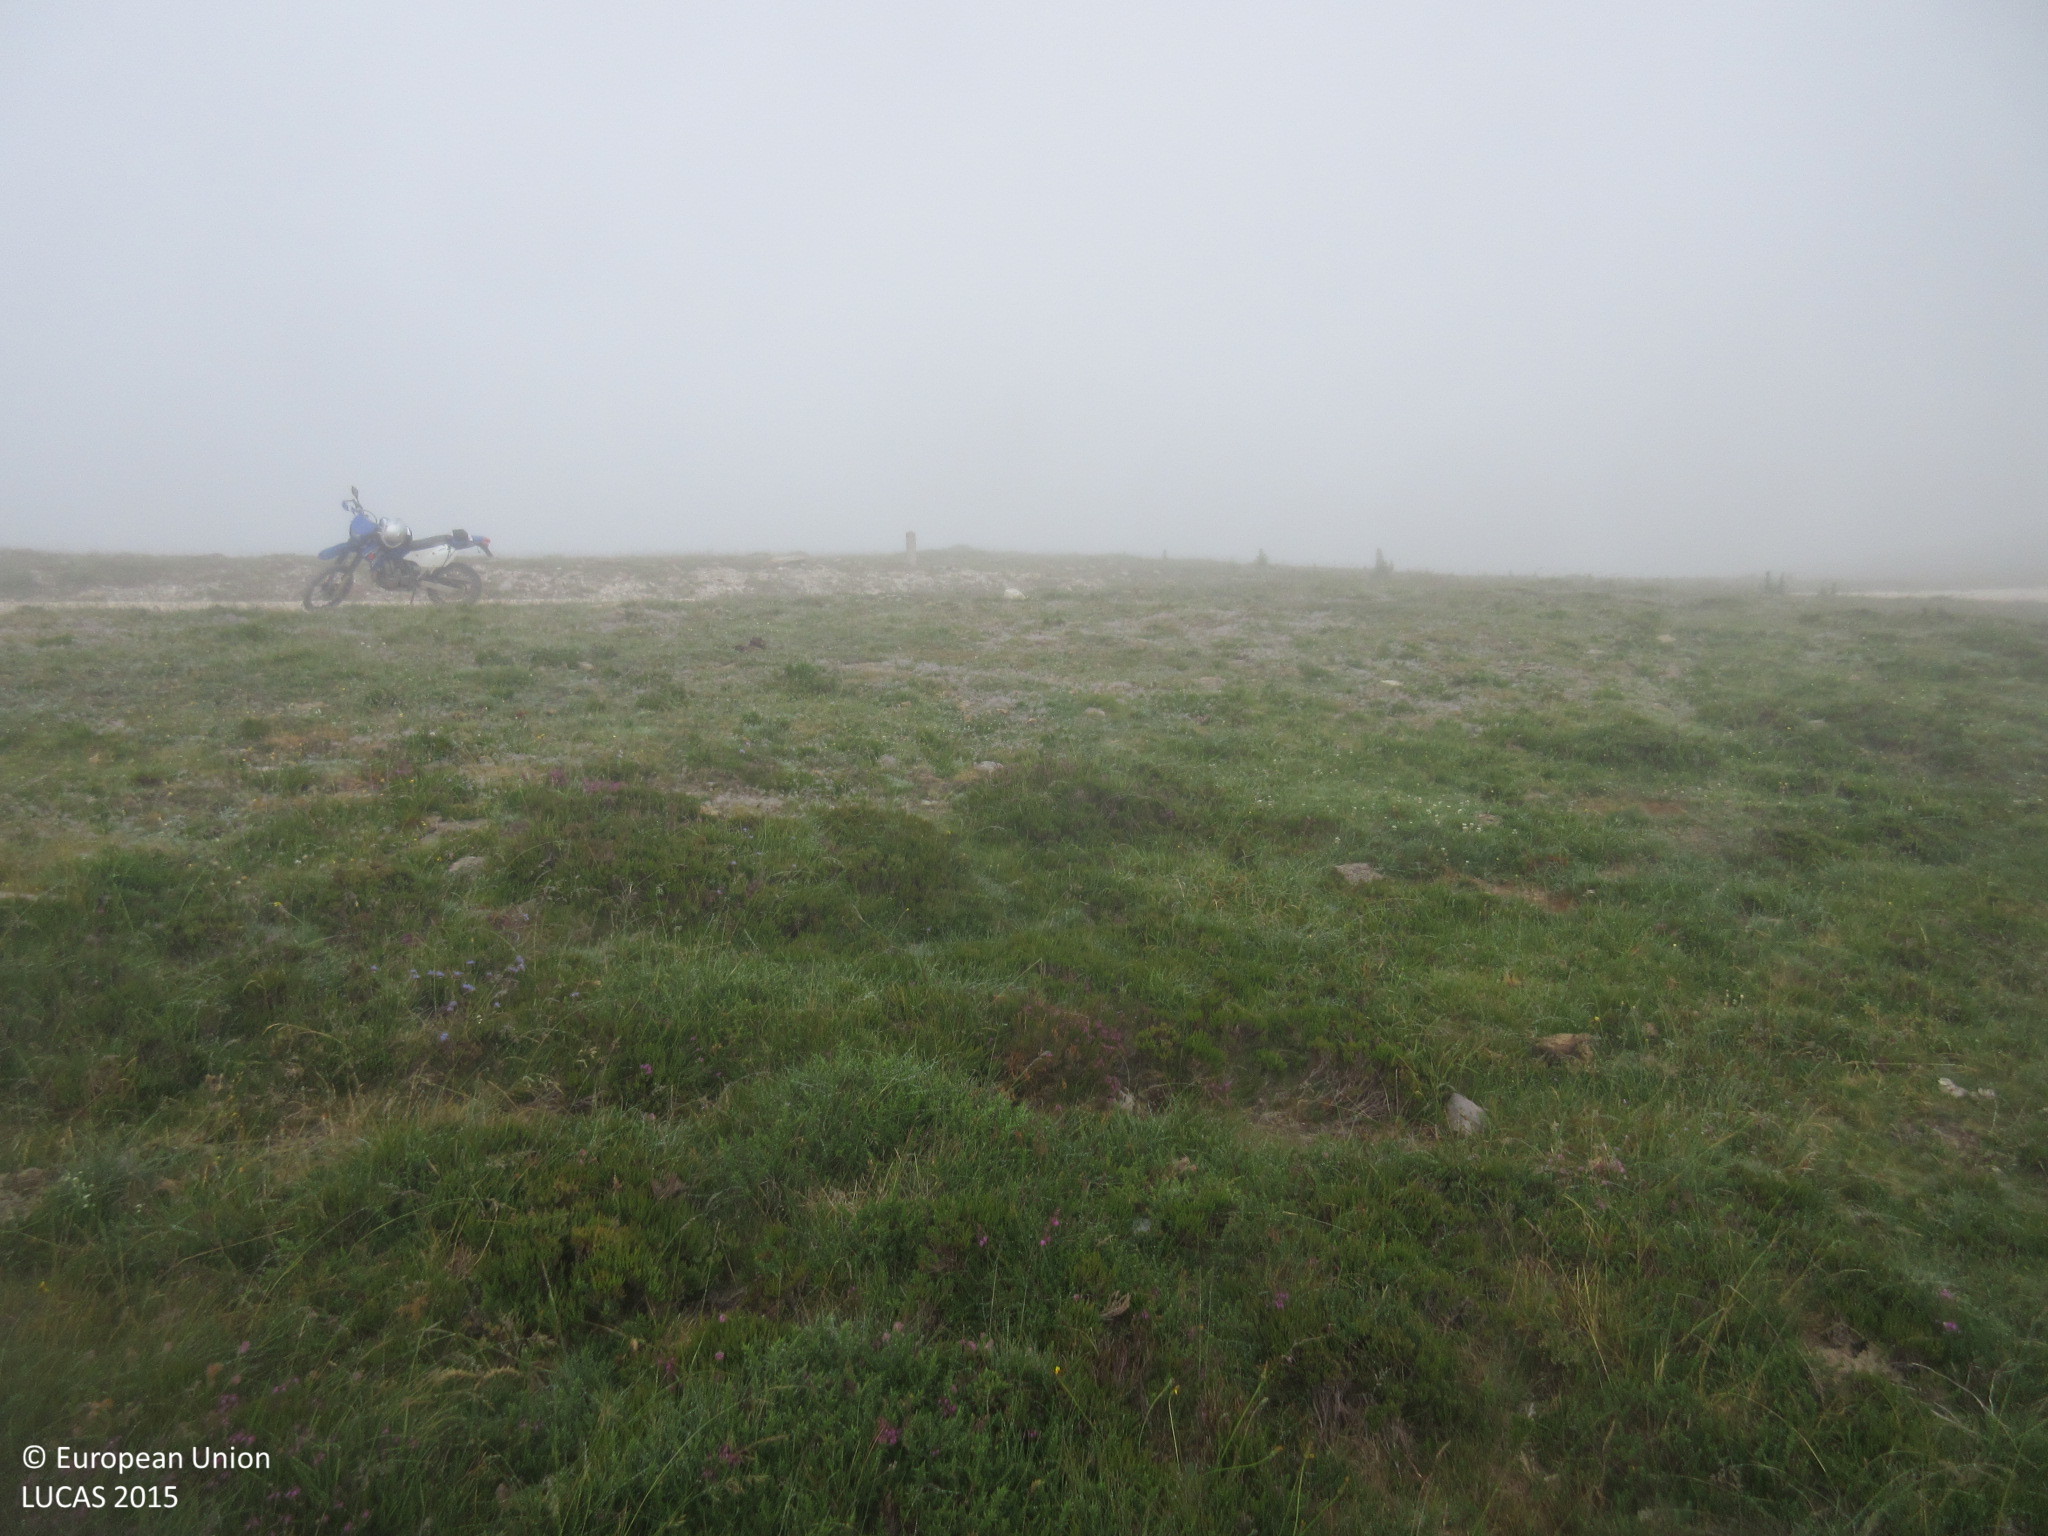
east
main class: Shrubland
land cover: Shrubland without tree cover
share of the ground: 50 - 75 %
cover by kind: shrubs 60 %, herbaceous plants 40 %
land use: Agriculture (excluding fallow land and kitchen gardens)
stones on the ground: 10 - 25 %
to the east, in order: Shrubland without tree cover; Grassland without tree/shrub cover; Tracks; Grassland without tree/shrub cover; Shrubland without tree cover
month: July
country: ES
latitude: 43.1457
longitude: -3.5553
